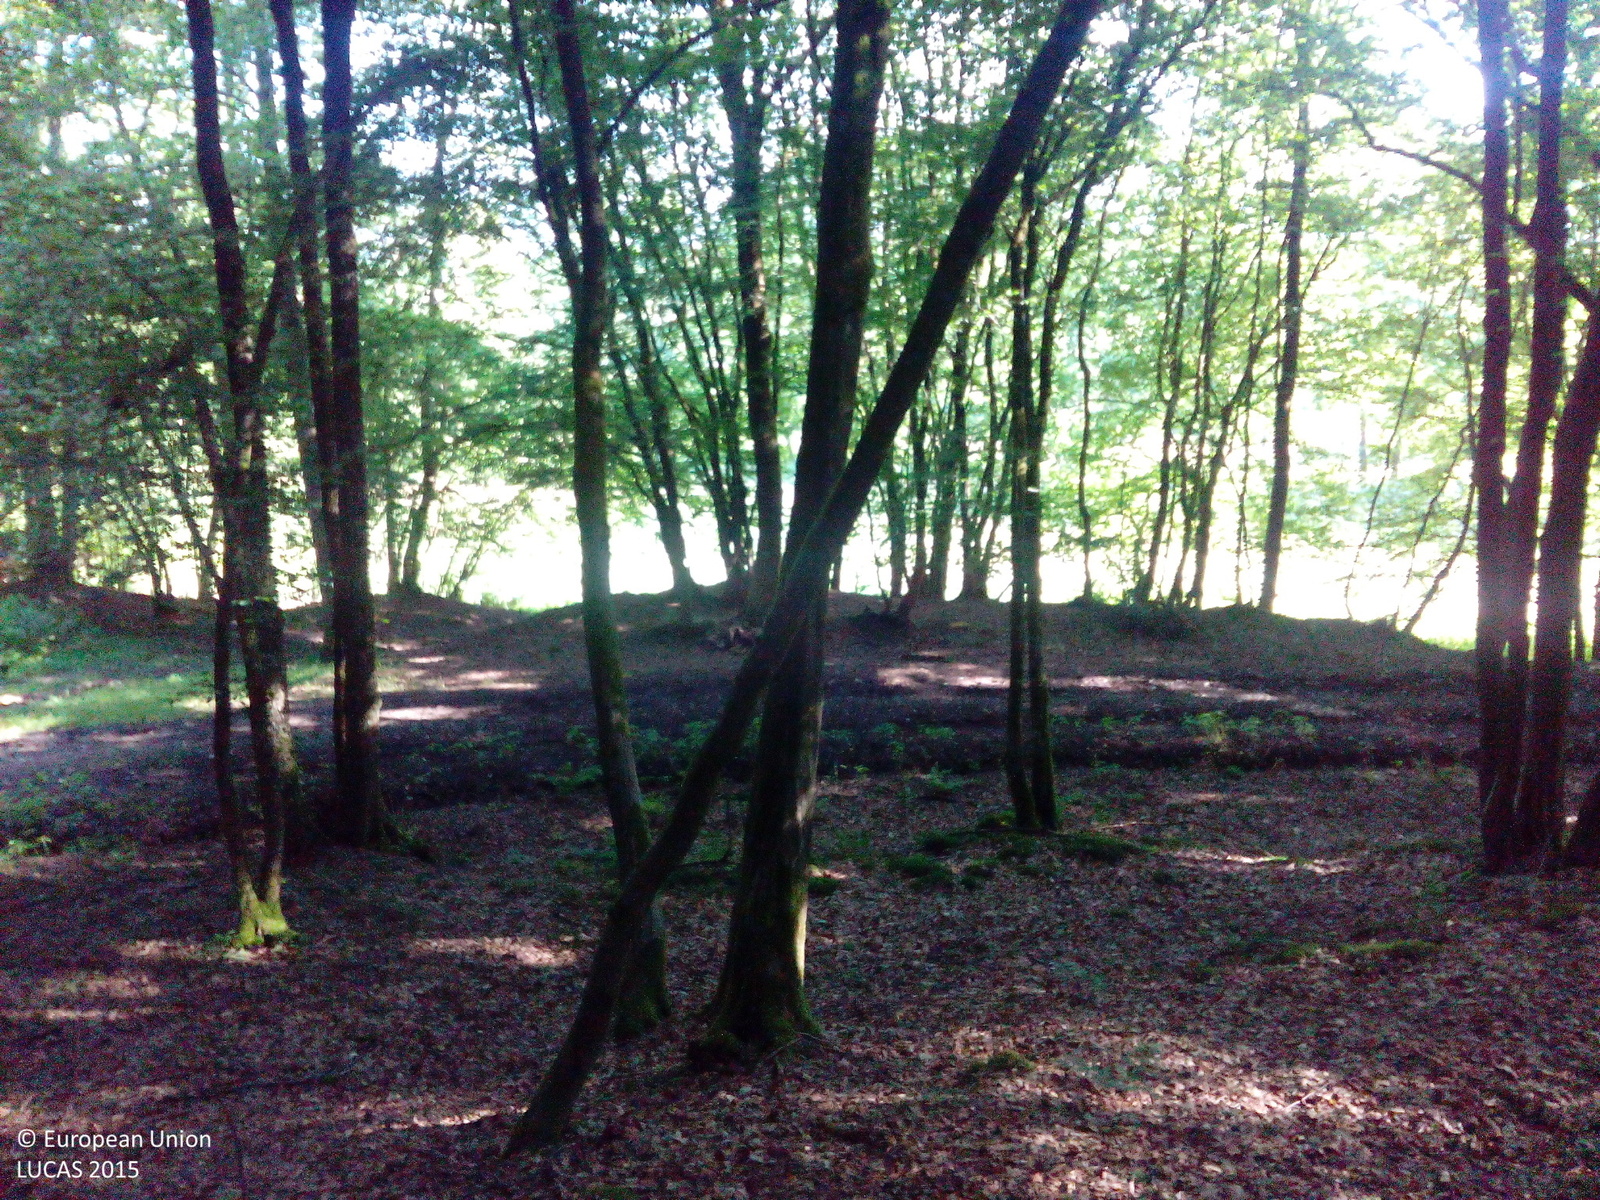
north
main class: Woodland
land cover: Broadleaved woodland
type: mesophytic deciduous forest
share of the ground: > 75 %
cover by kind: broadleaved forest trees 85 %, coniferous forest trees 15 %
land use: Forestry
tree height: > 5 m
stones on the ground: < 10 %
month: June
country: DE
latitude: 50.8748
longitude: 7.4279
